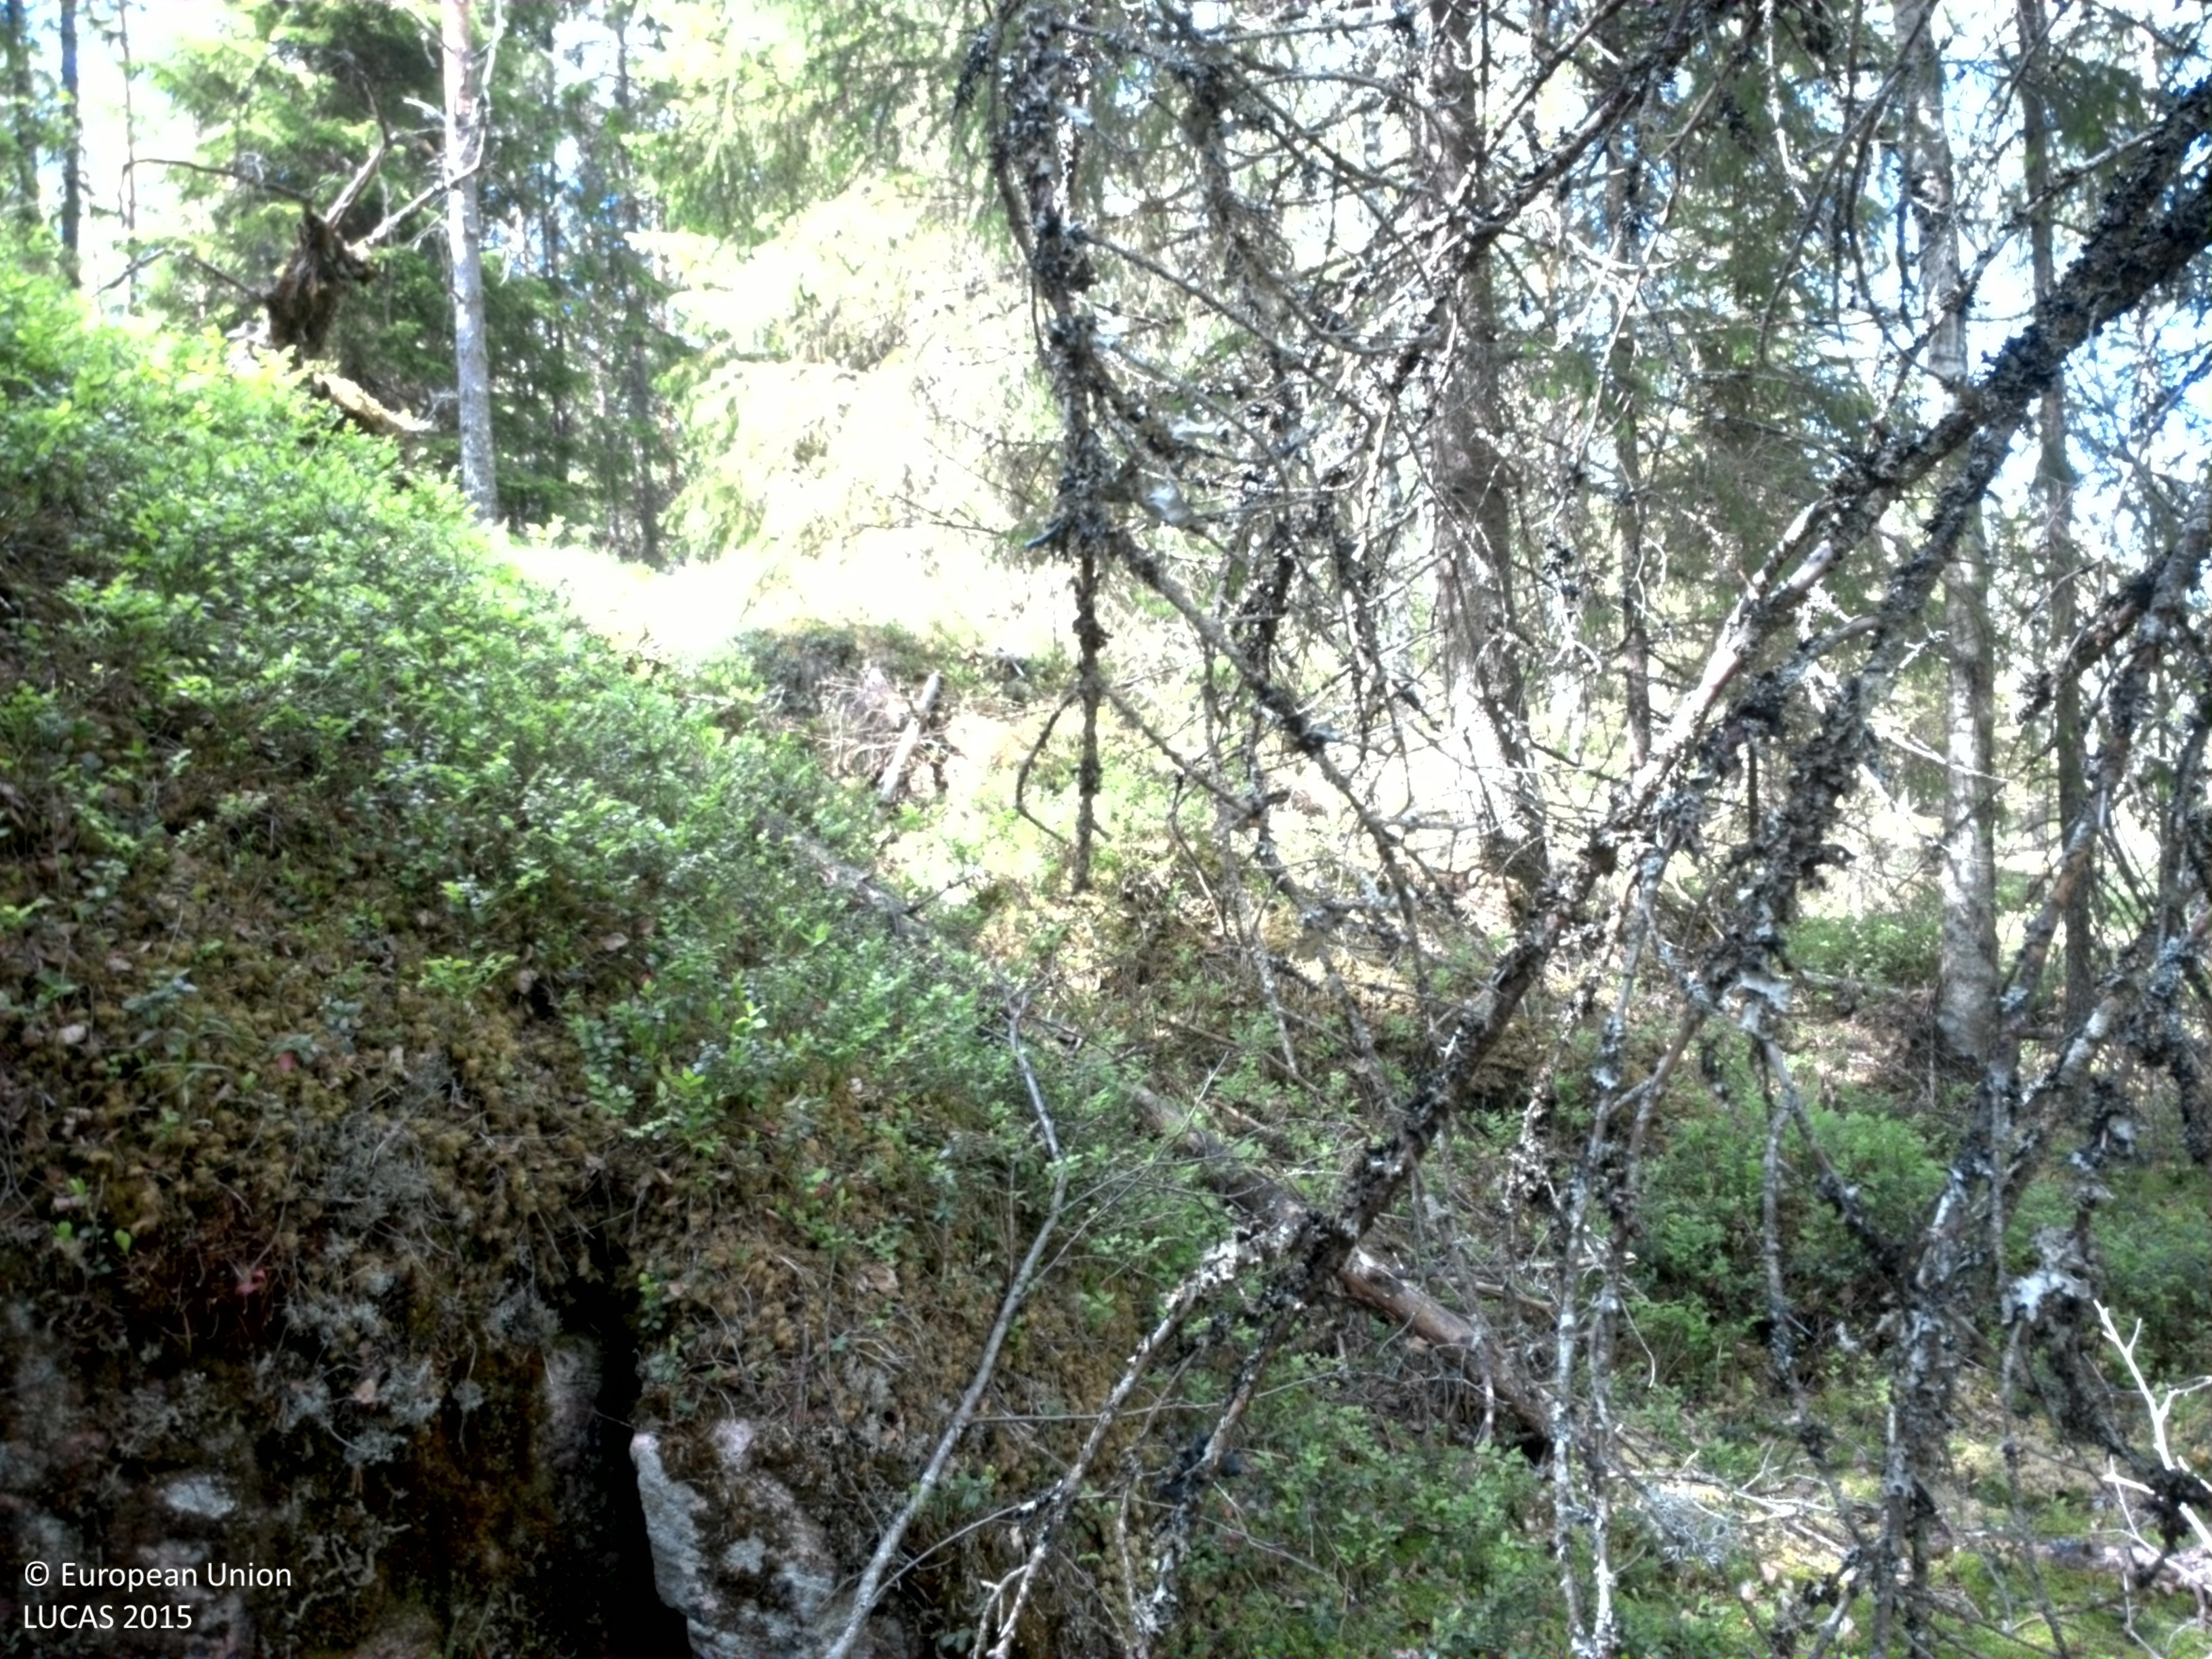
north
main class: Woodland
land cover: Pine dominated mixed woodland
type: boreal forest
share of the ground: 25 - 50 %
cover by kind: coniferous forest trees 35 %, lichens and mosses 25 %, shrubs 20 %, broadleaved forest trees 15 %, herbaceous plants 5 %
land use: Forestry
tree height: > 5 m
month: June
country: SE
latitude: 59.6258
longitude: 12.0335
